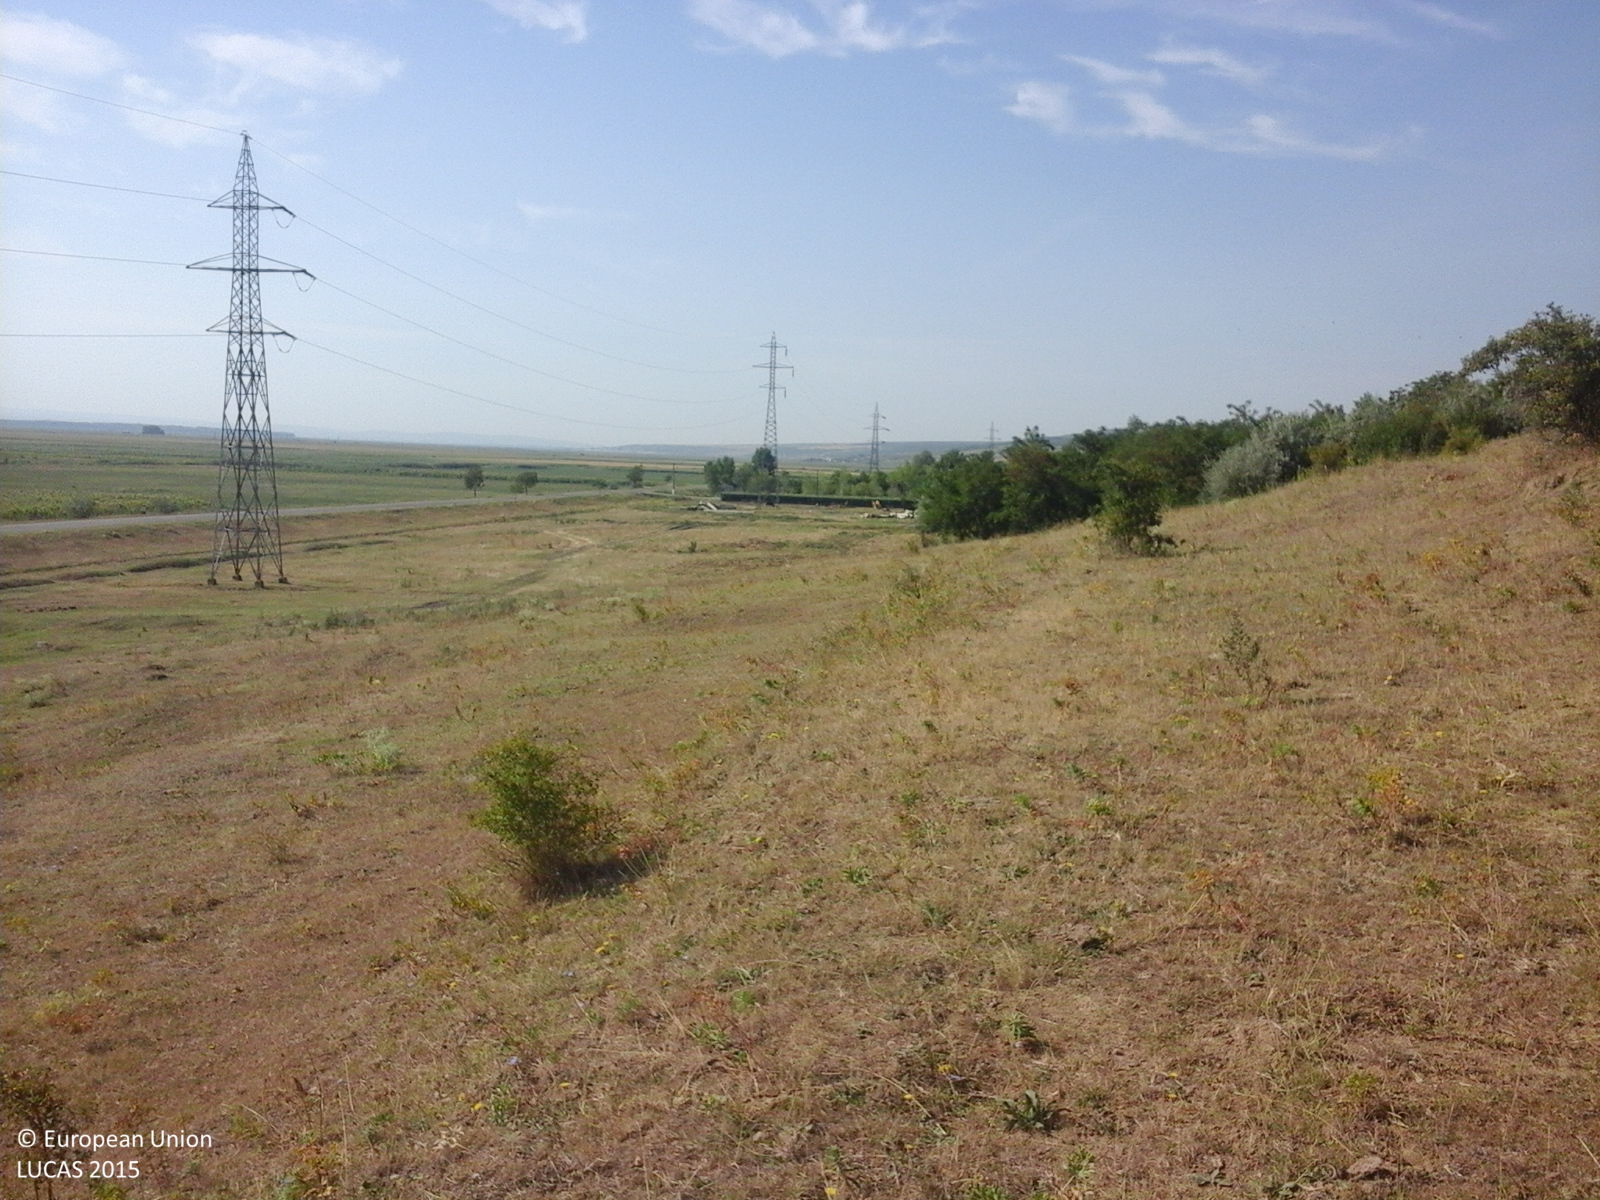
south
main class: Grassland
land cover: Grassland with sparse tree/shrub cover
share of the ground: > 75 %
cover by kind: herbaceous plants 85 %, shrubs 10 %, broadleaved forest trees 5 %
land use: Agriculture (excluding fallow land and kitchen gardens)
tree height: < 5 m
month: July
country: RO
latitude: 46.5661
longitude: 28.1754
